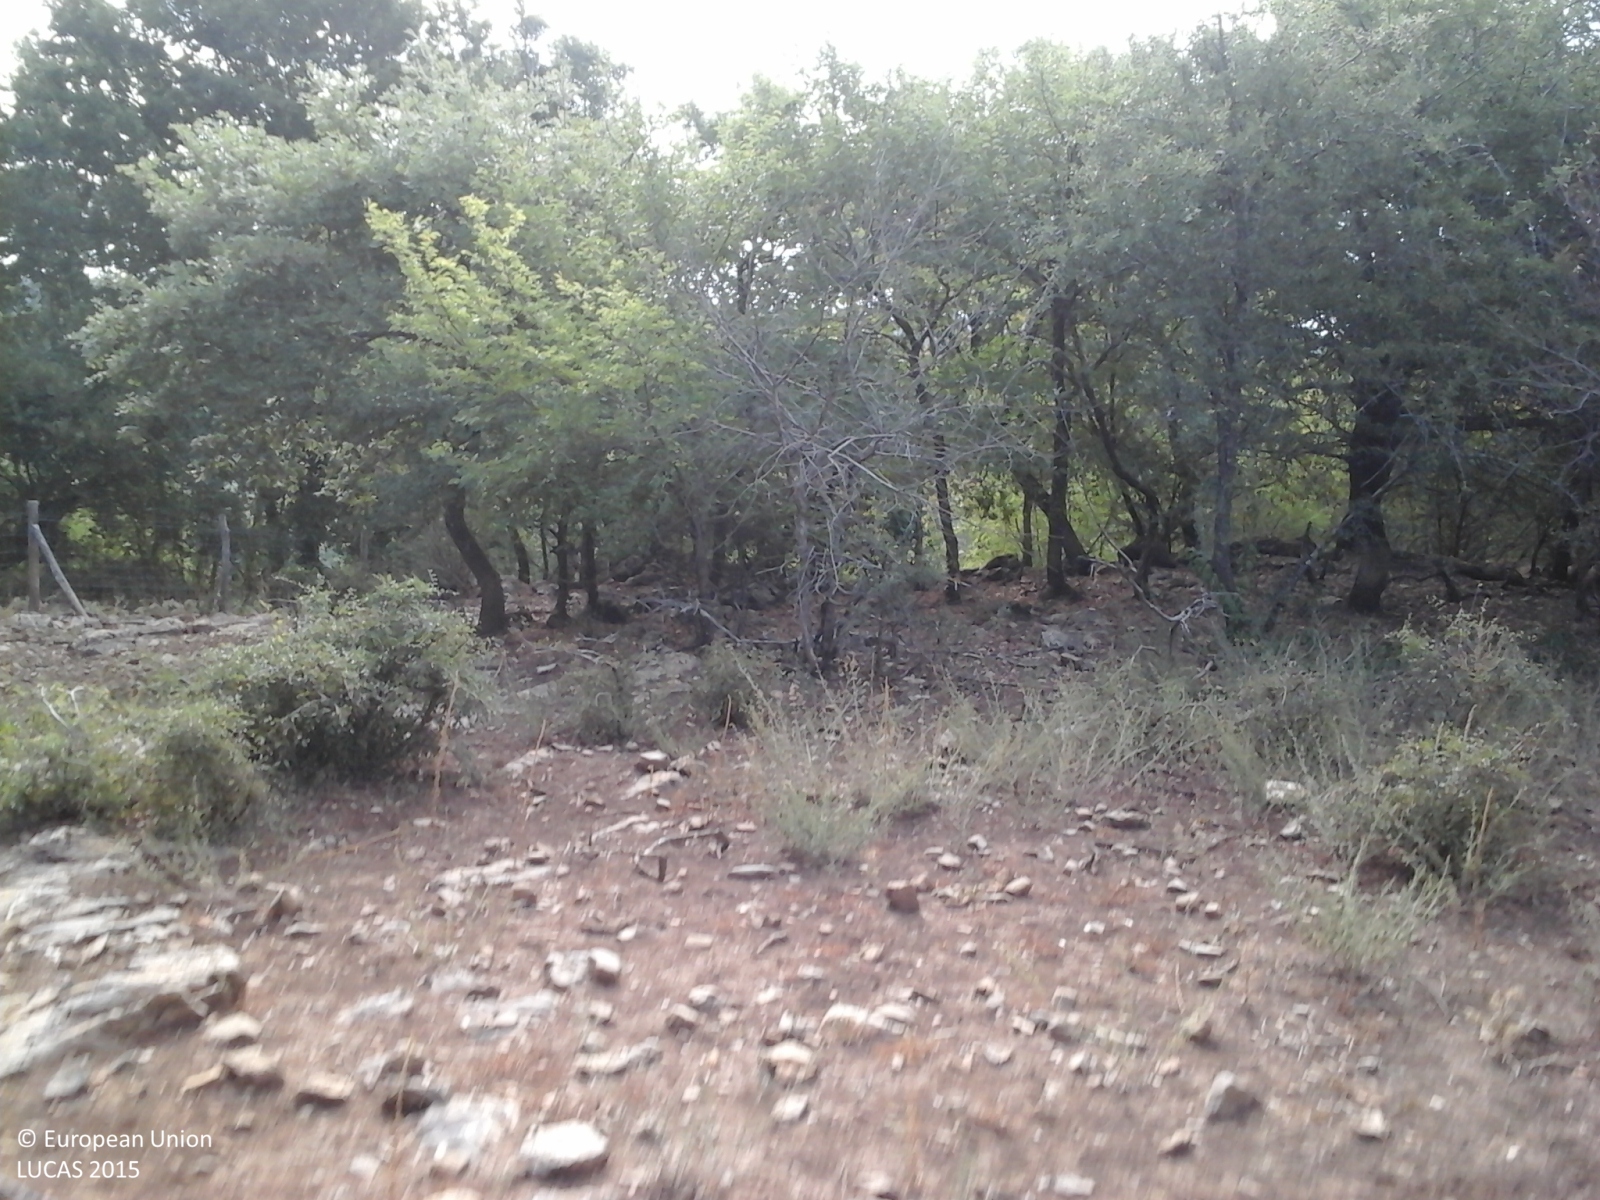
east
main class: Shrubland
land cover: Shrubland with sparse tree cover
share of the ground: 25 - 50 %
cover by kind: shrubs 55 %, herbaceous plants 20 %, unconsolidated bare surface 20 %, broadleaved forest trees 5 %
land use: Agriculture (excluding fallow land and kitchen gardens)
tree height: < 5 m
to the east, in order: Shrubland with sparse tree cover; Fences; Tracks; Fences; Shrubland with sparse tree cover; Olive groves; Grassland with sparse tree/shrub cover; Fences; Paved roads, cycling and walking lanes; Fences; Broadleaved woodland; Other bare soil
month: August
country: IT
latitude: 42.6069
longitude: 11.4943
